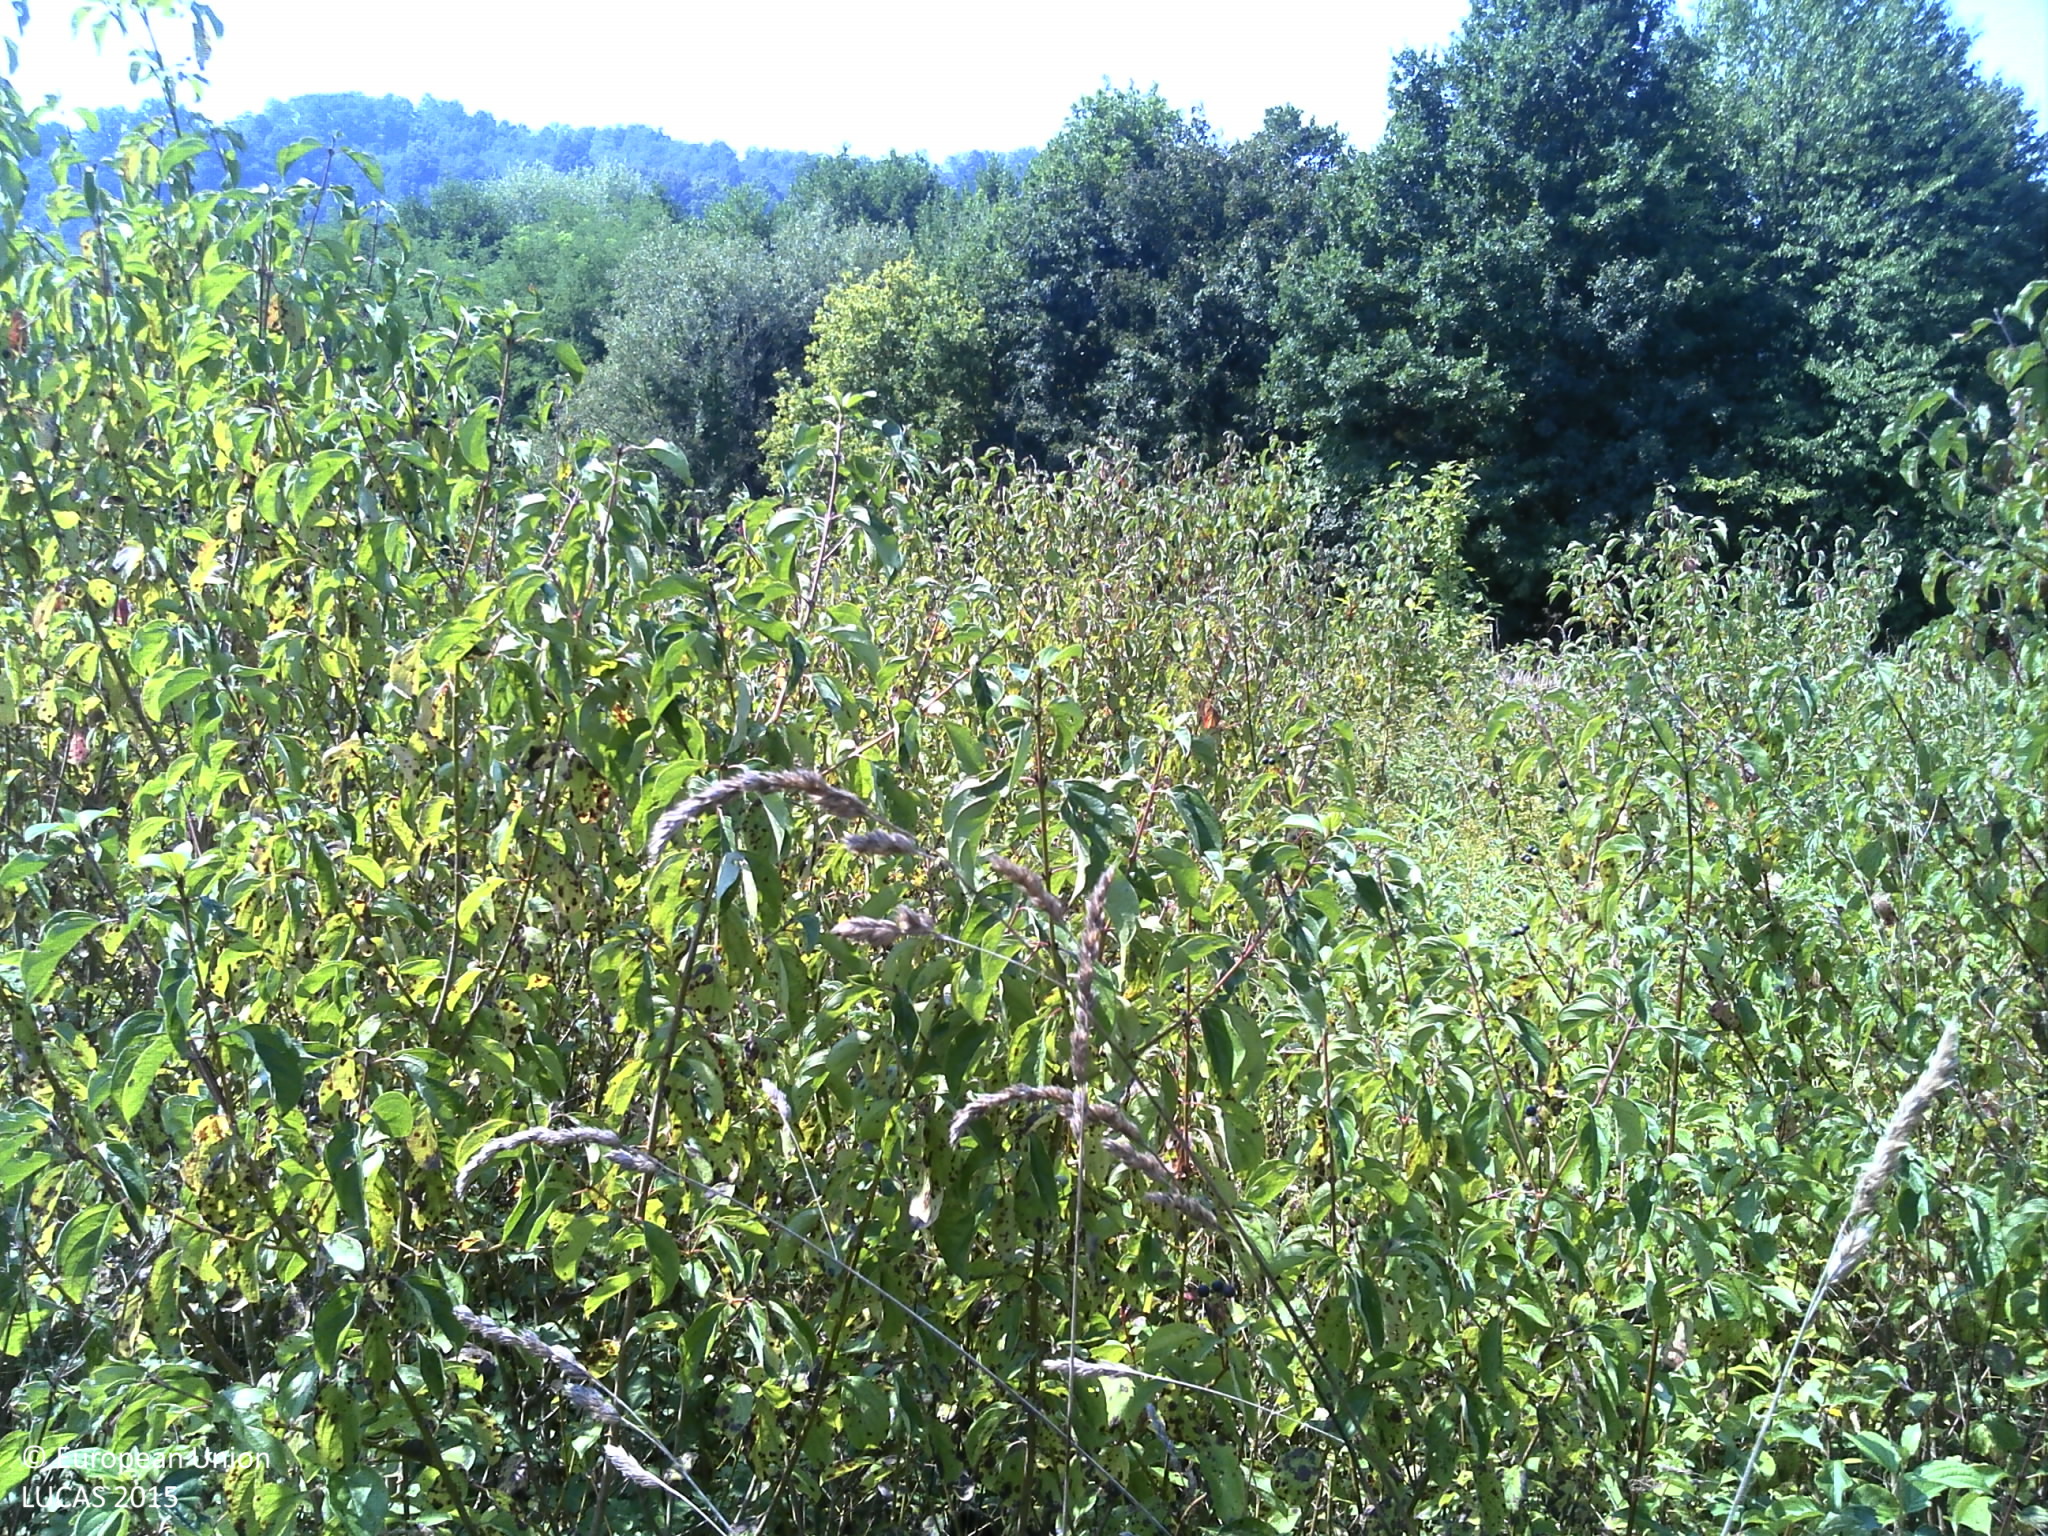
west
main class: Shrubland
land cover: Shrubland with sparse tree cover
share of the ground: > 75 %
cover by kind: shrubs 95 %, broadleaved forest trees 5 %
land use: Semi-natural and natural areas not in use
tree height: < 5 m
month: August
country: HR
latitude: 45.1447
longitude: 16.4449
